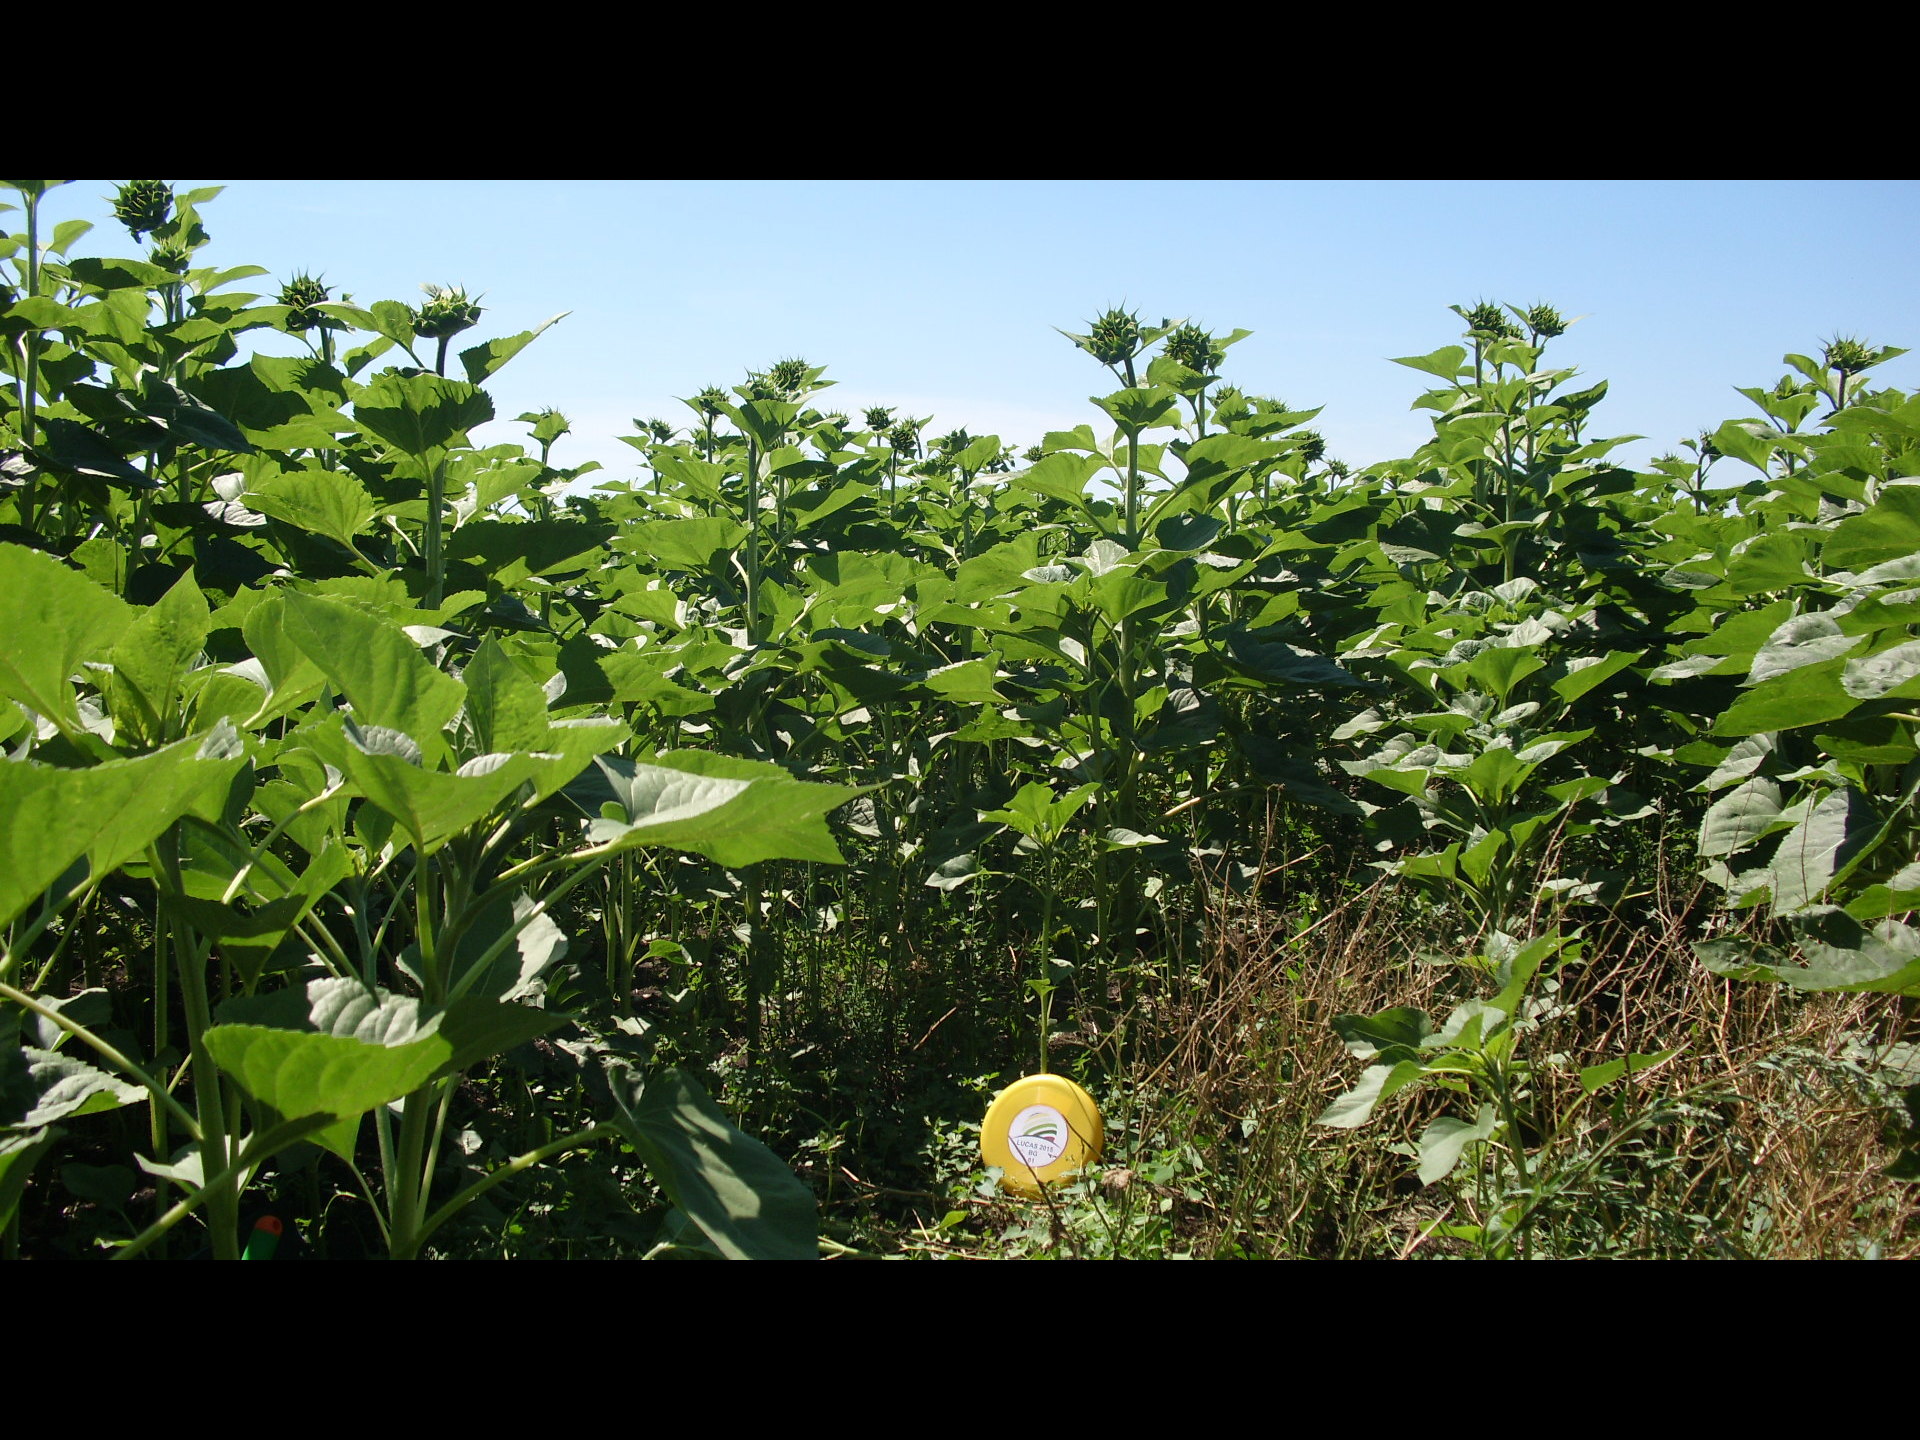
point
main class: Cropland
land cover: Sunflower
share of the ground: > 75 %
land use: Agriculture (excluding fallow land and kitchen gardens)
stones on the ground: < 10 %
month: June
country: BG
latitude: 43.5598
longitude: 23.3259
